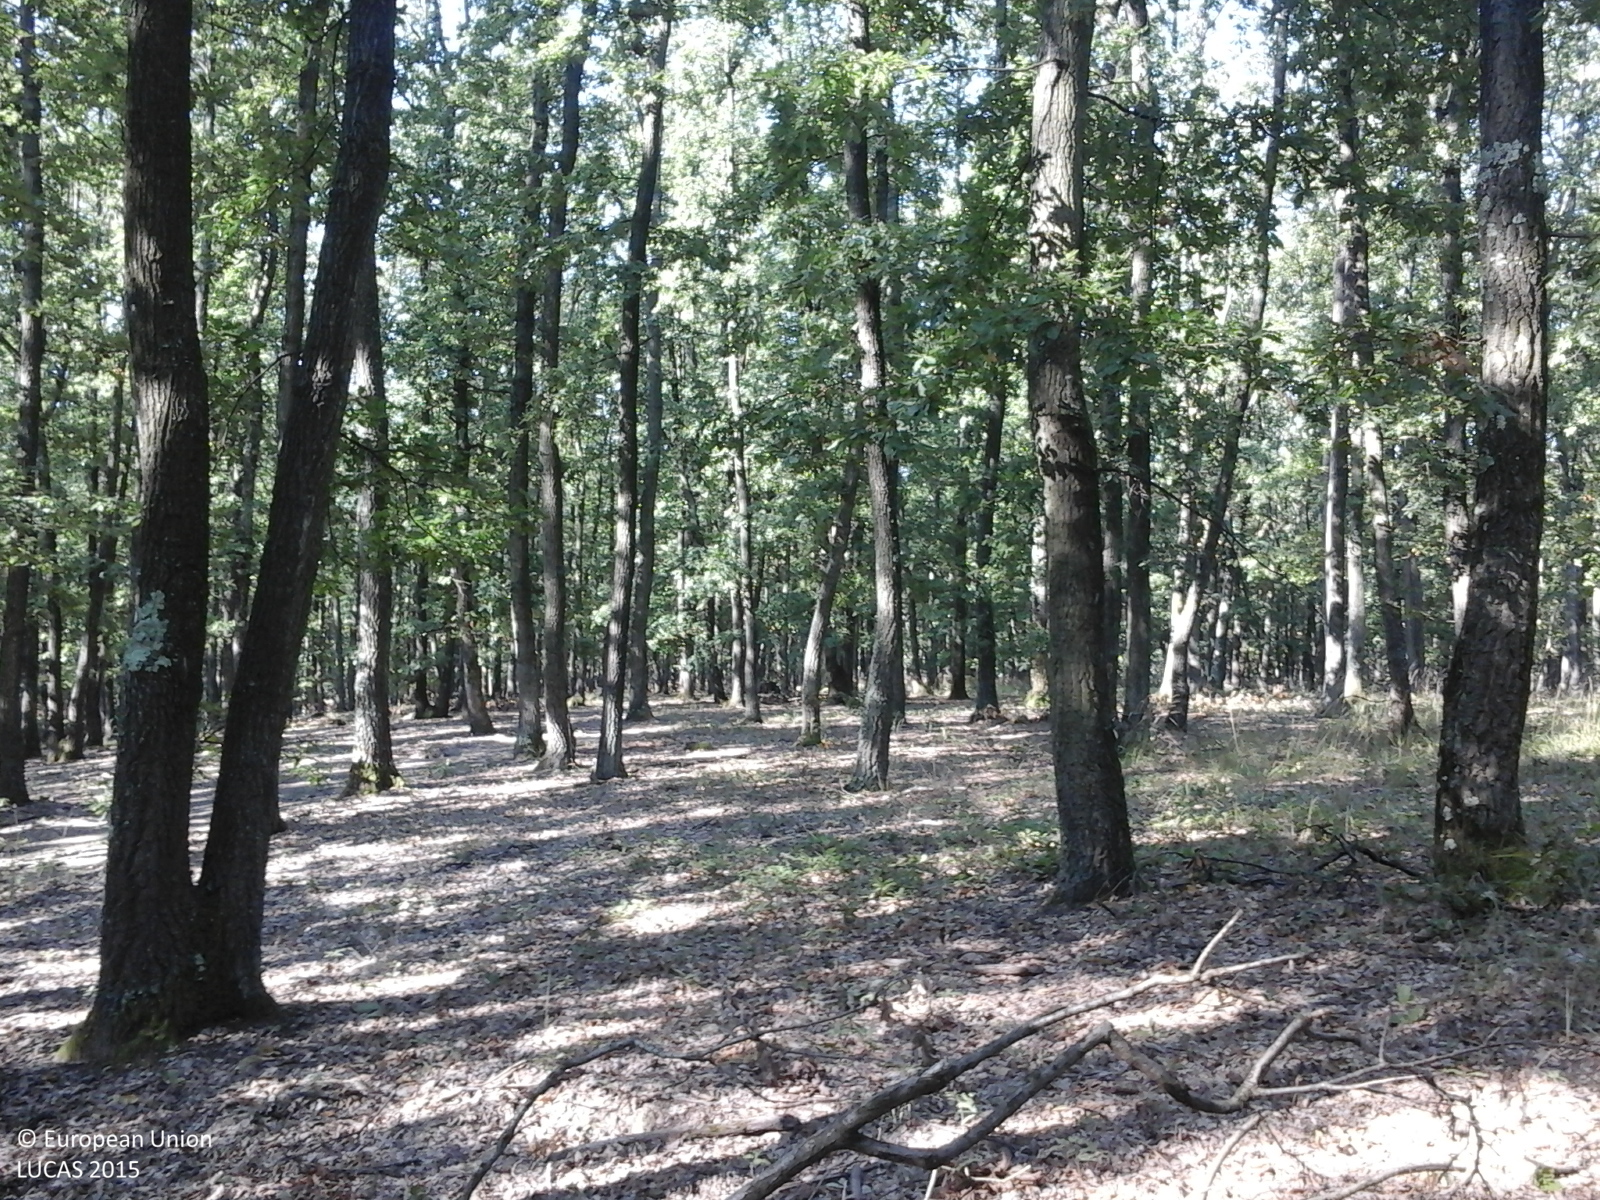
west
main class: Woodland
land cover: Broadleaved woodland
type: acidophilous oak and oak-birch forest
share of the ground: > 75 %
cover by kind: broadleaved forest trees 100 %
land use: Forestry
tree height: > 5 m
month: September
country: RO
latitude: 47.4138
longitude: 22.6902
